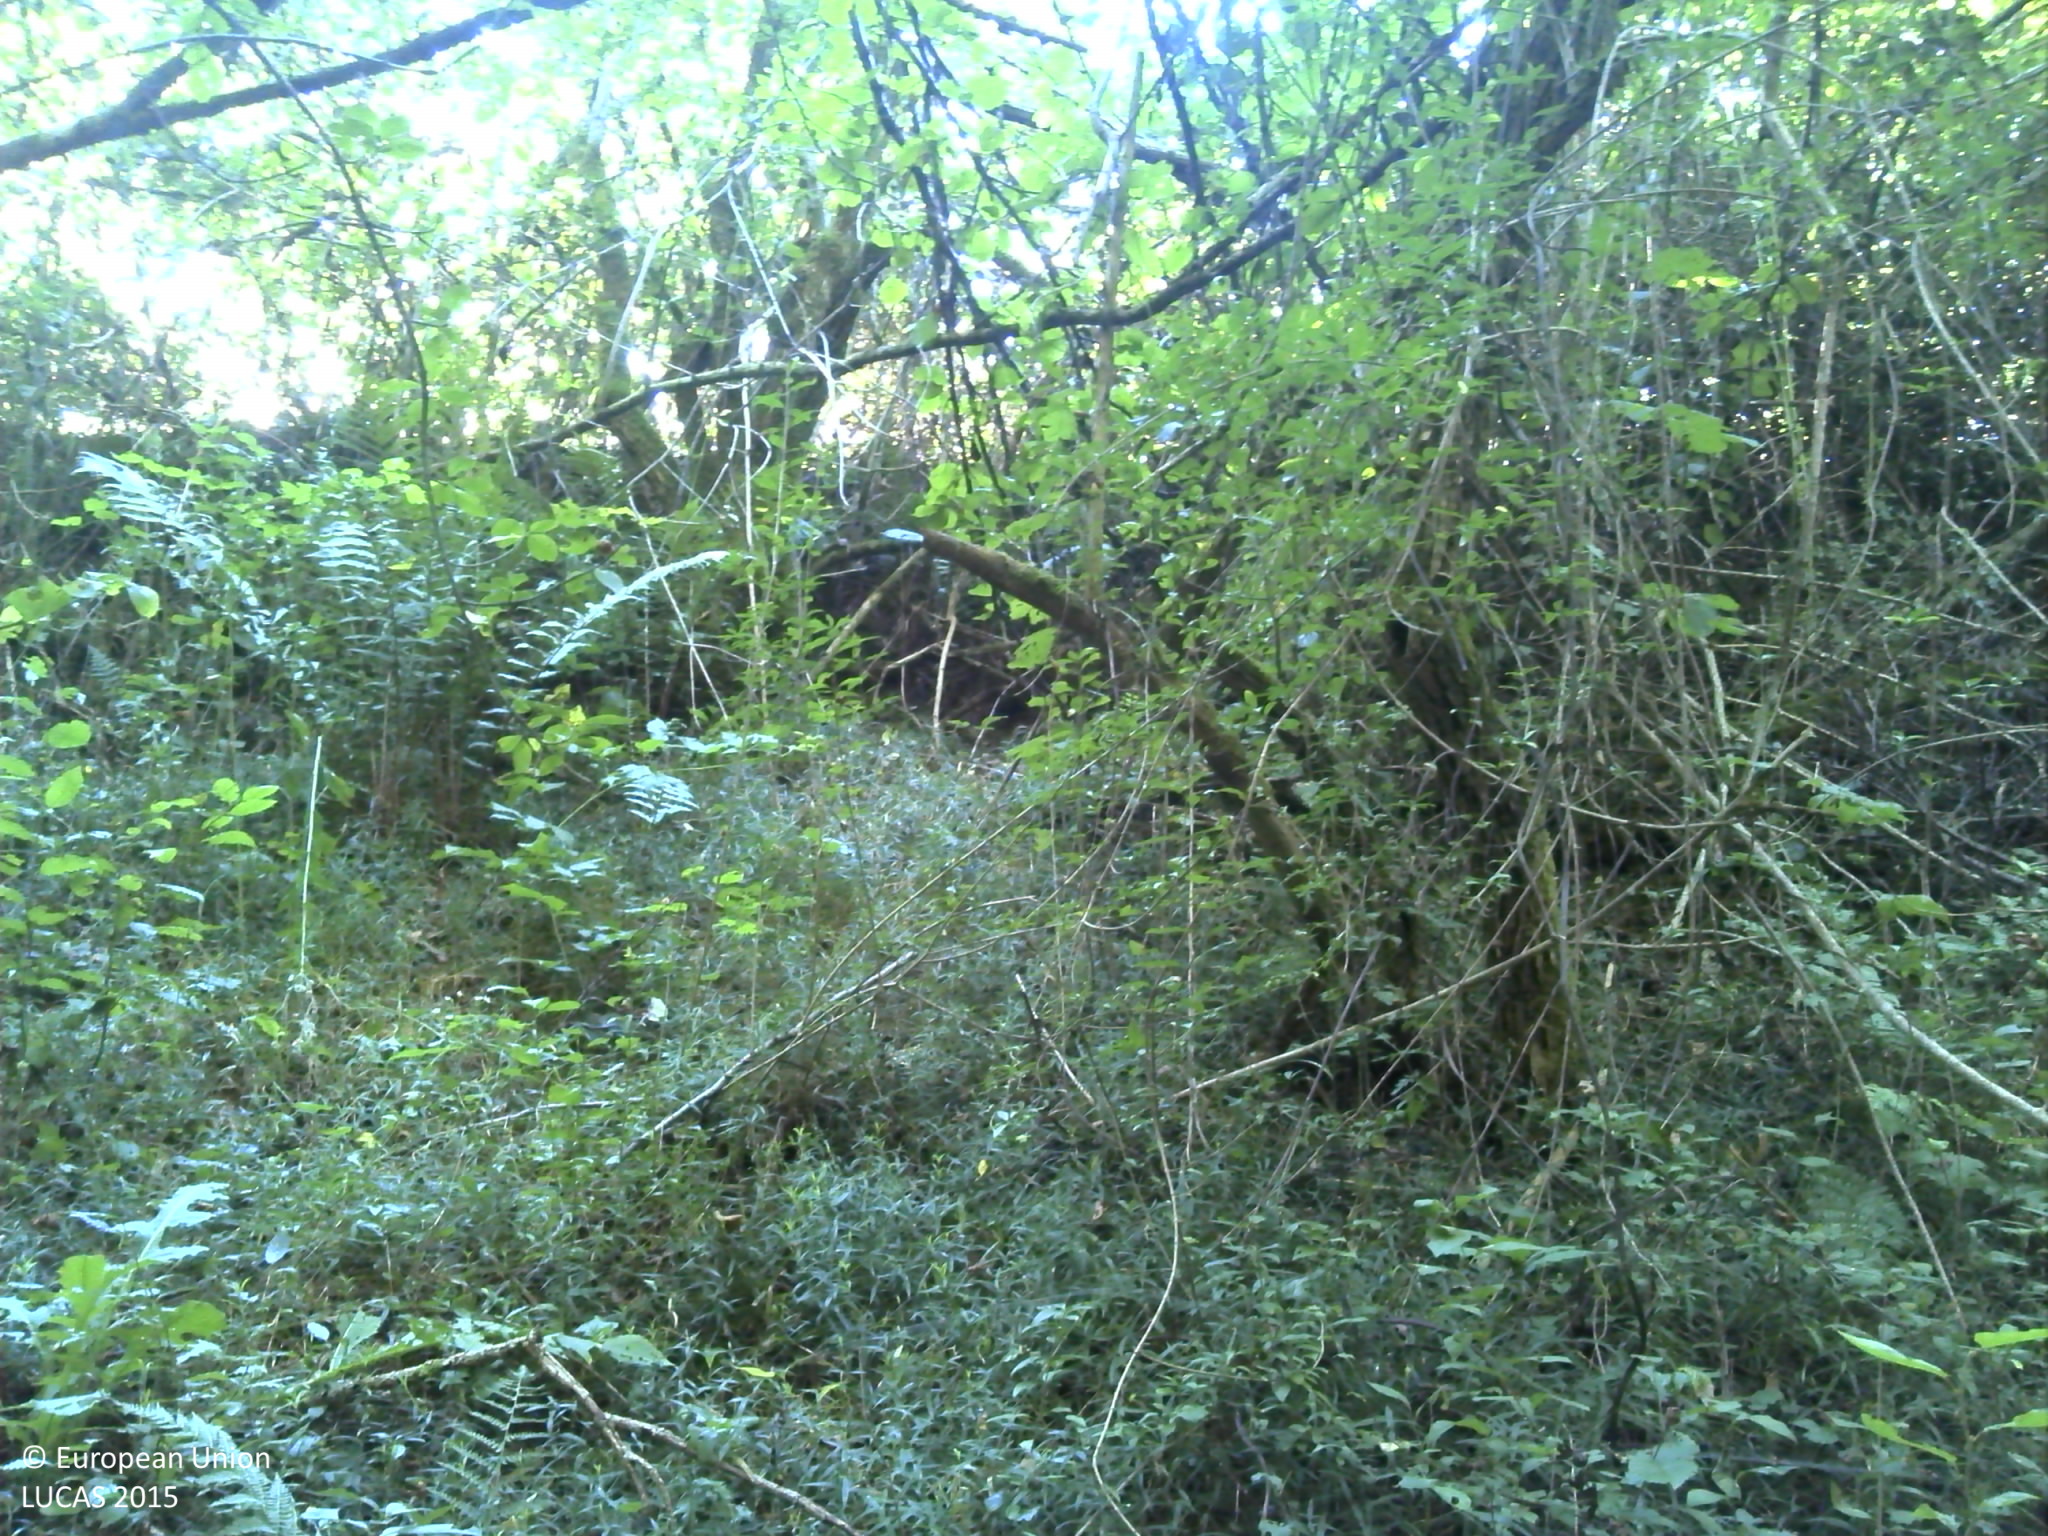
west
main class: Woodland
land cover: Broadleaved woodland
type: beech forest
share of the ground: > 75 %
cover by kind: broadleaved forest trees 100 %
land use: Forestry
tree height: > 5 m
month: August
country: HR
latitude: 45.1165
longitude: 16.3142
